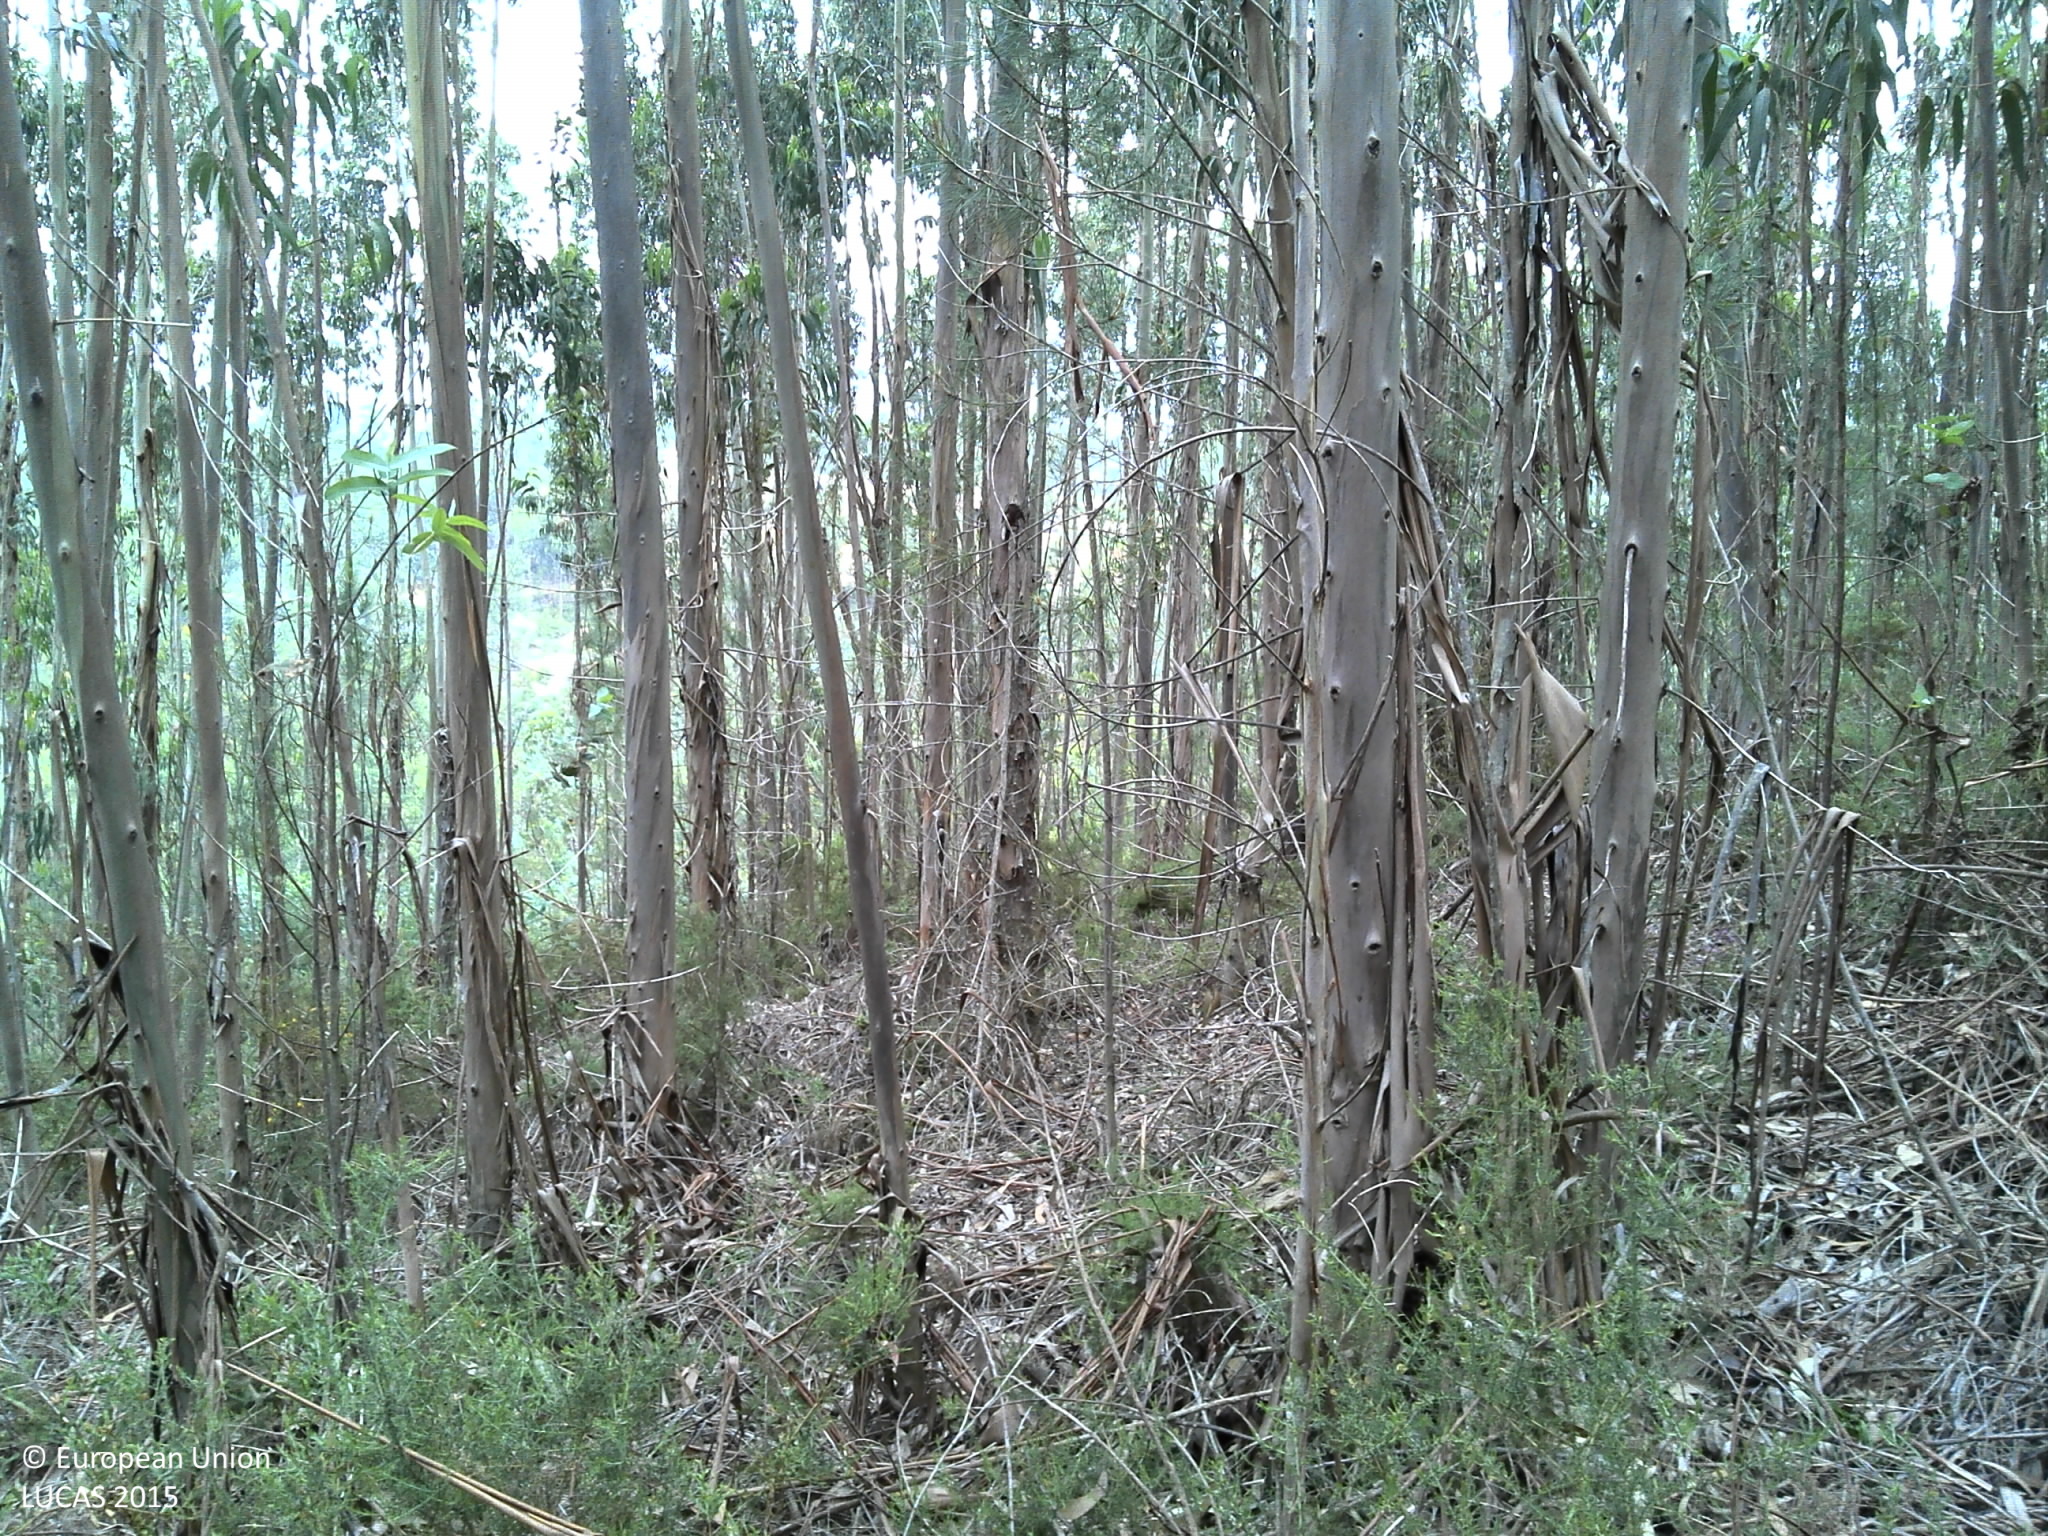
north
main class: Woodland
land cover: Broadleaved woodland
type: exotic forest
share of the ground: > 75 %
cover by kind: broadleaved forest trees 85 %, shrubs 15 %
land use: Forestry
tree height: > 5 m
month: May
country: PT
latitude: 41.0643
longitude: -8.3873
